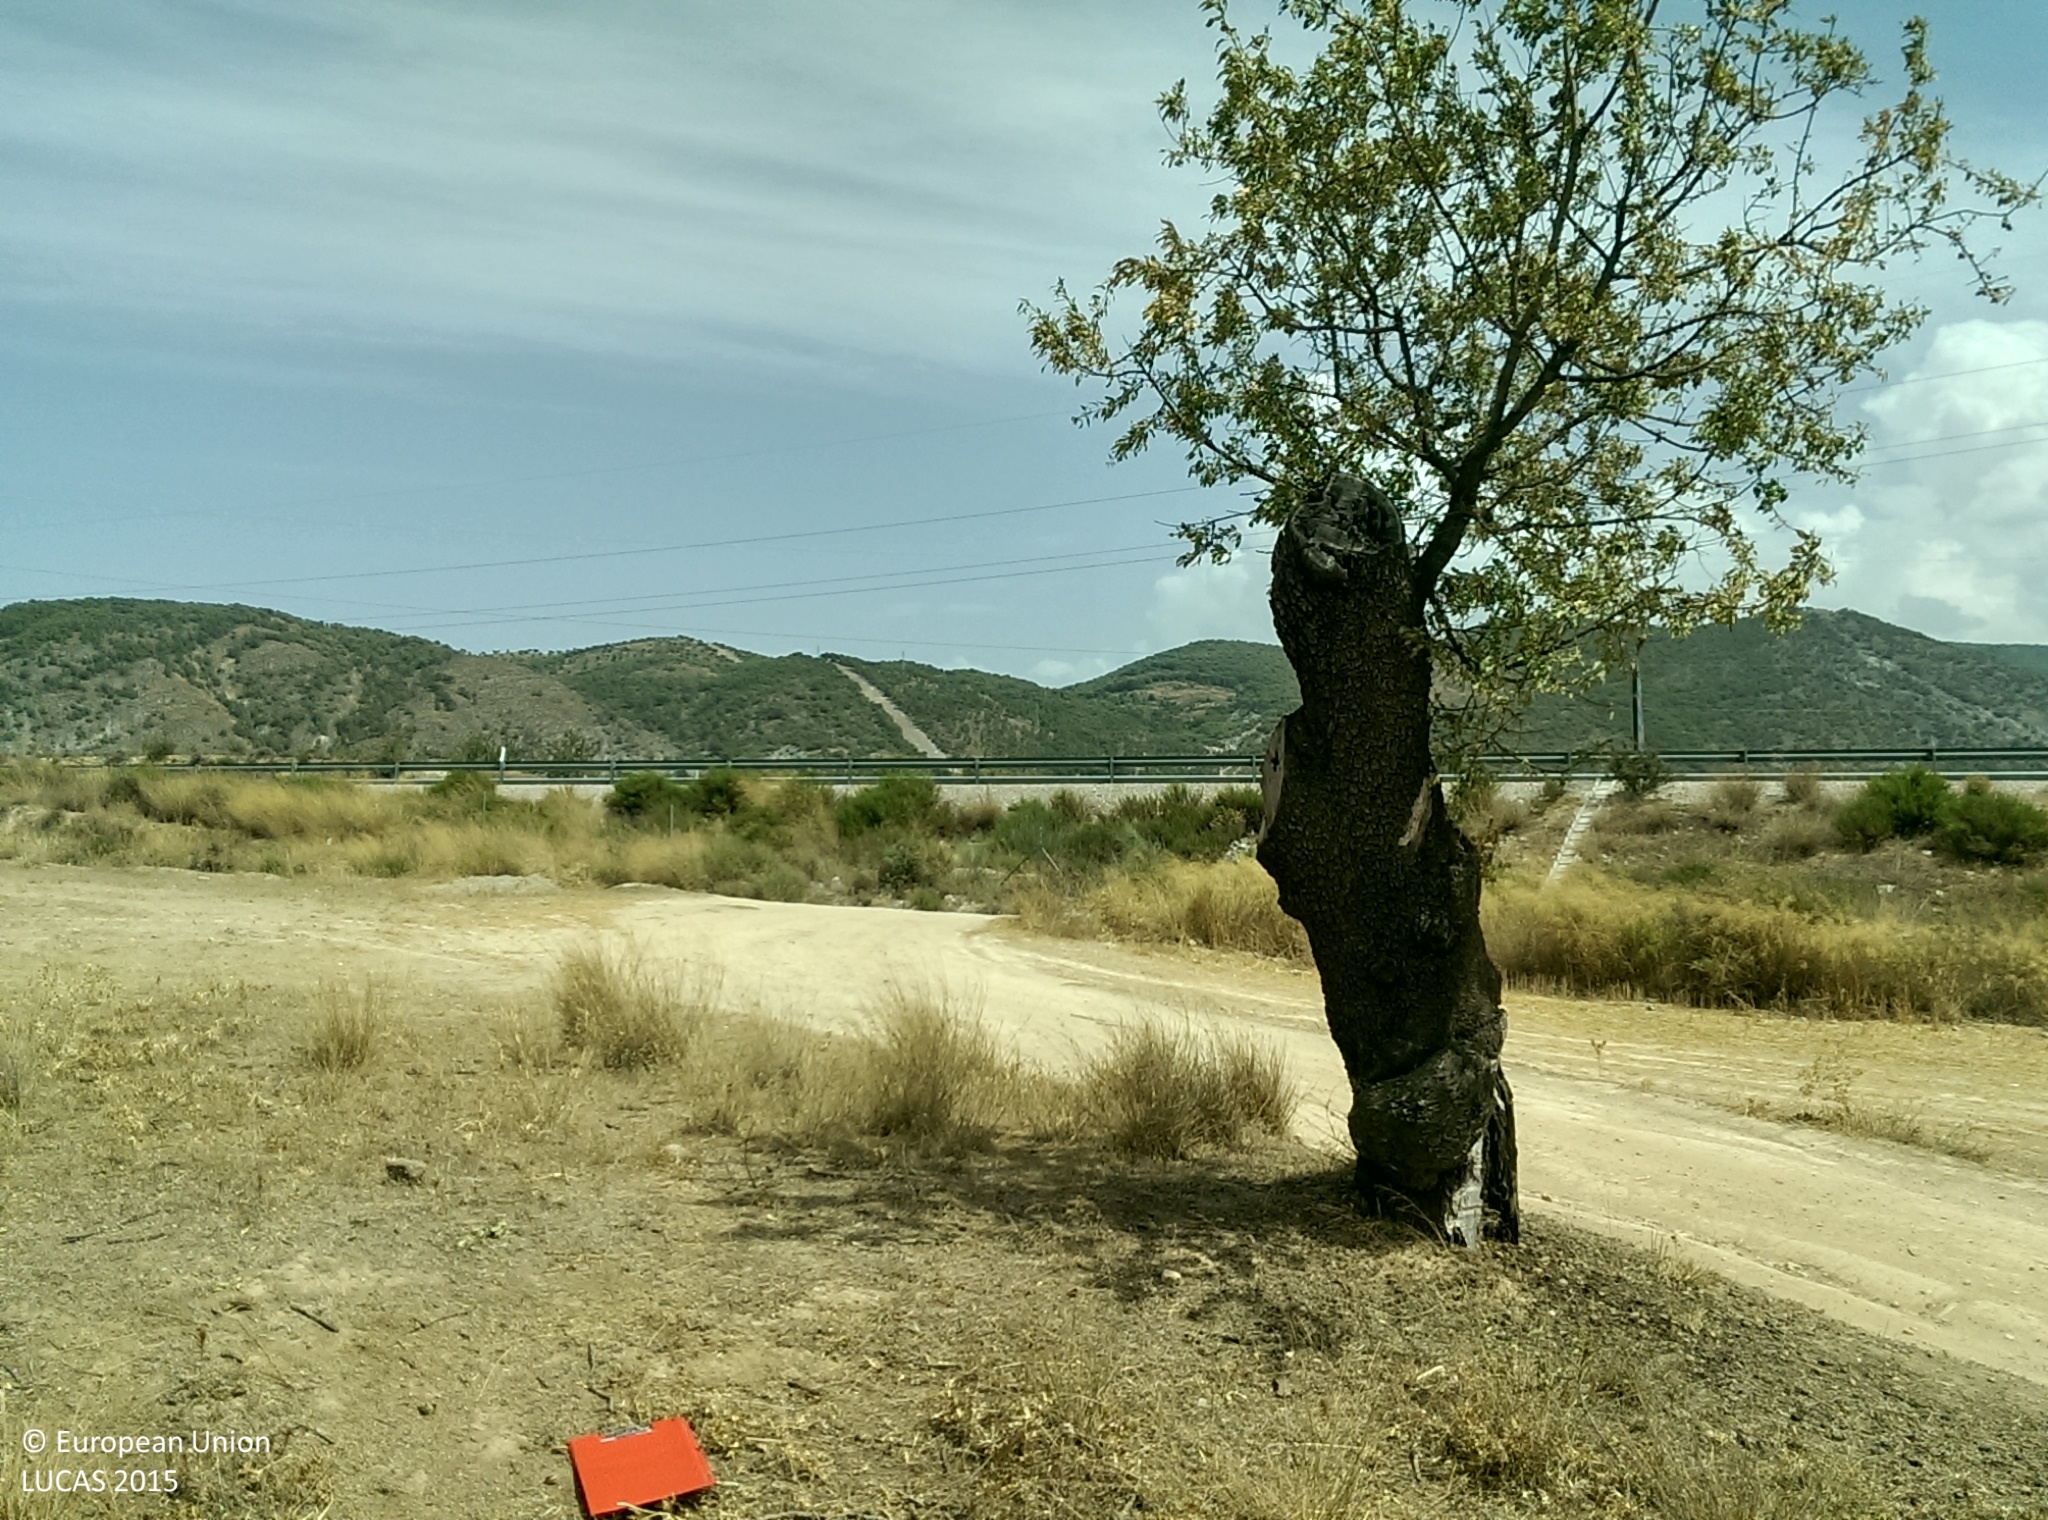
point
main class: Cropland
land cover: Nuts trees
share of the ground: 10 - 25 %
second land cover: Other bare soil
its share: > 75 %
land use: Agriculture (excluding fallow land and kitchen gardens)
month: August
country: ES
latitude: 37.0343
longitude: -3.6464
